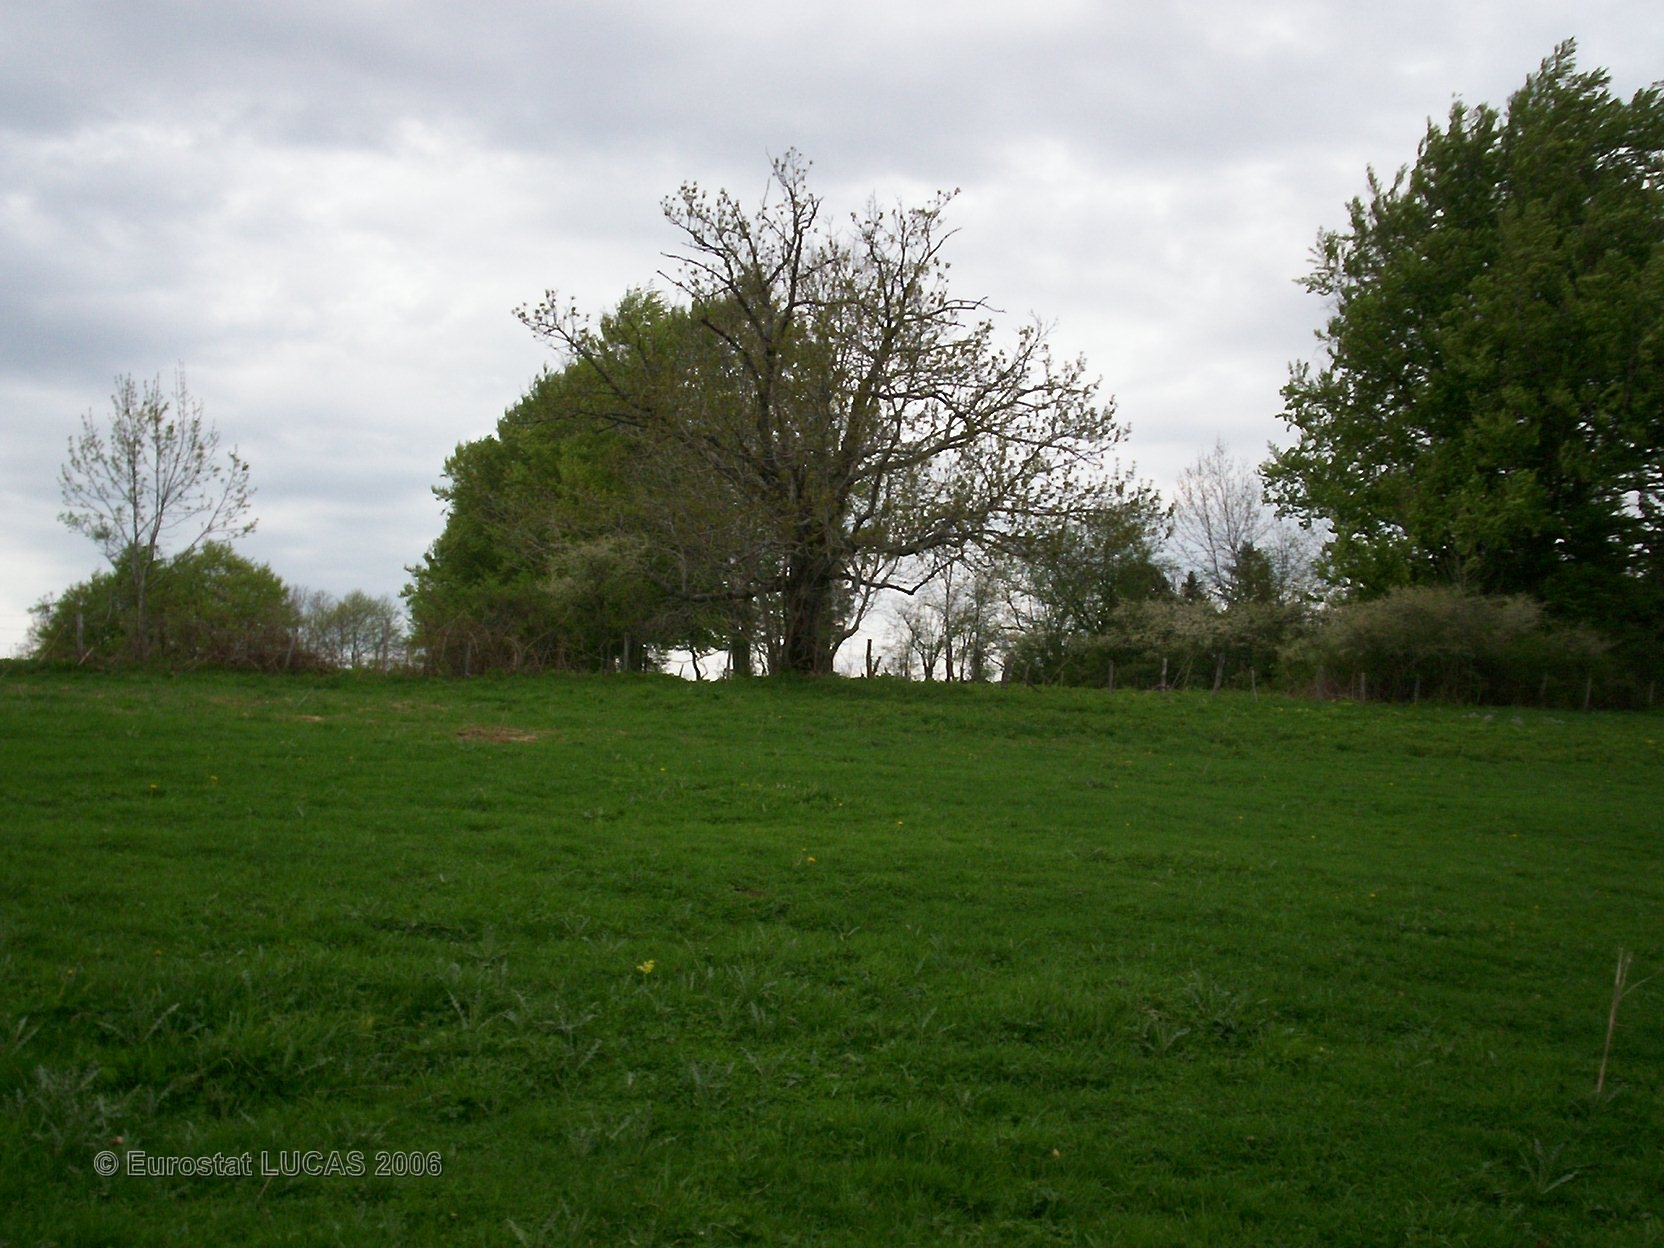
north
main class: Grassland
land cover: Grassland without tree/shrub cover
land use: Agriculture (excluding fallow land and kitchen gardens)
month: May
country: FR
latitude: 47.2238
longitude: 6.8457
